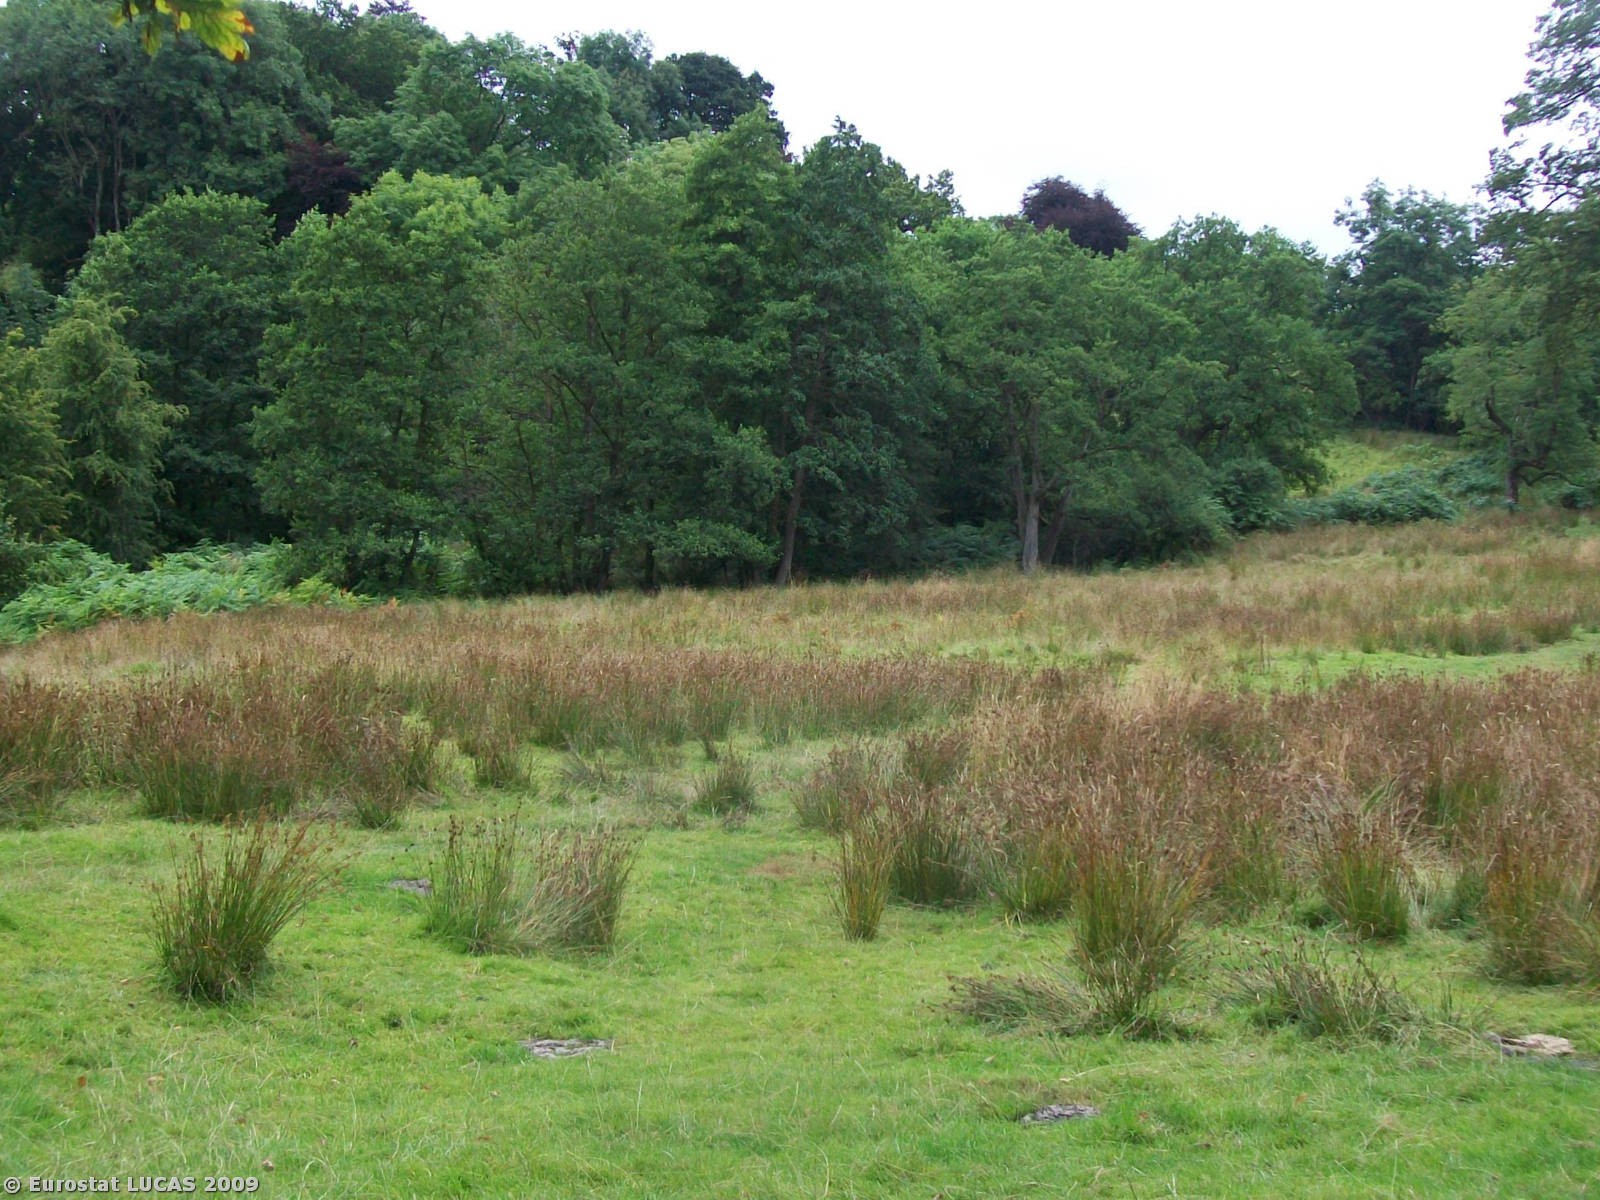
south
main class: Grassland
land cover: Grassland with sparse tree/shrub cover
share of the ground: > 75 %
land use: Agriculture (excluding fallow land and kitchen gardens)
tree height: > 5 m
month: August
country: GB
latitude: 52.5678
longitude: -3.3448
